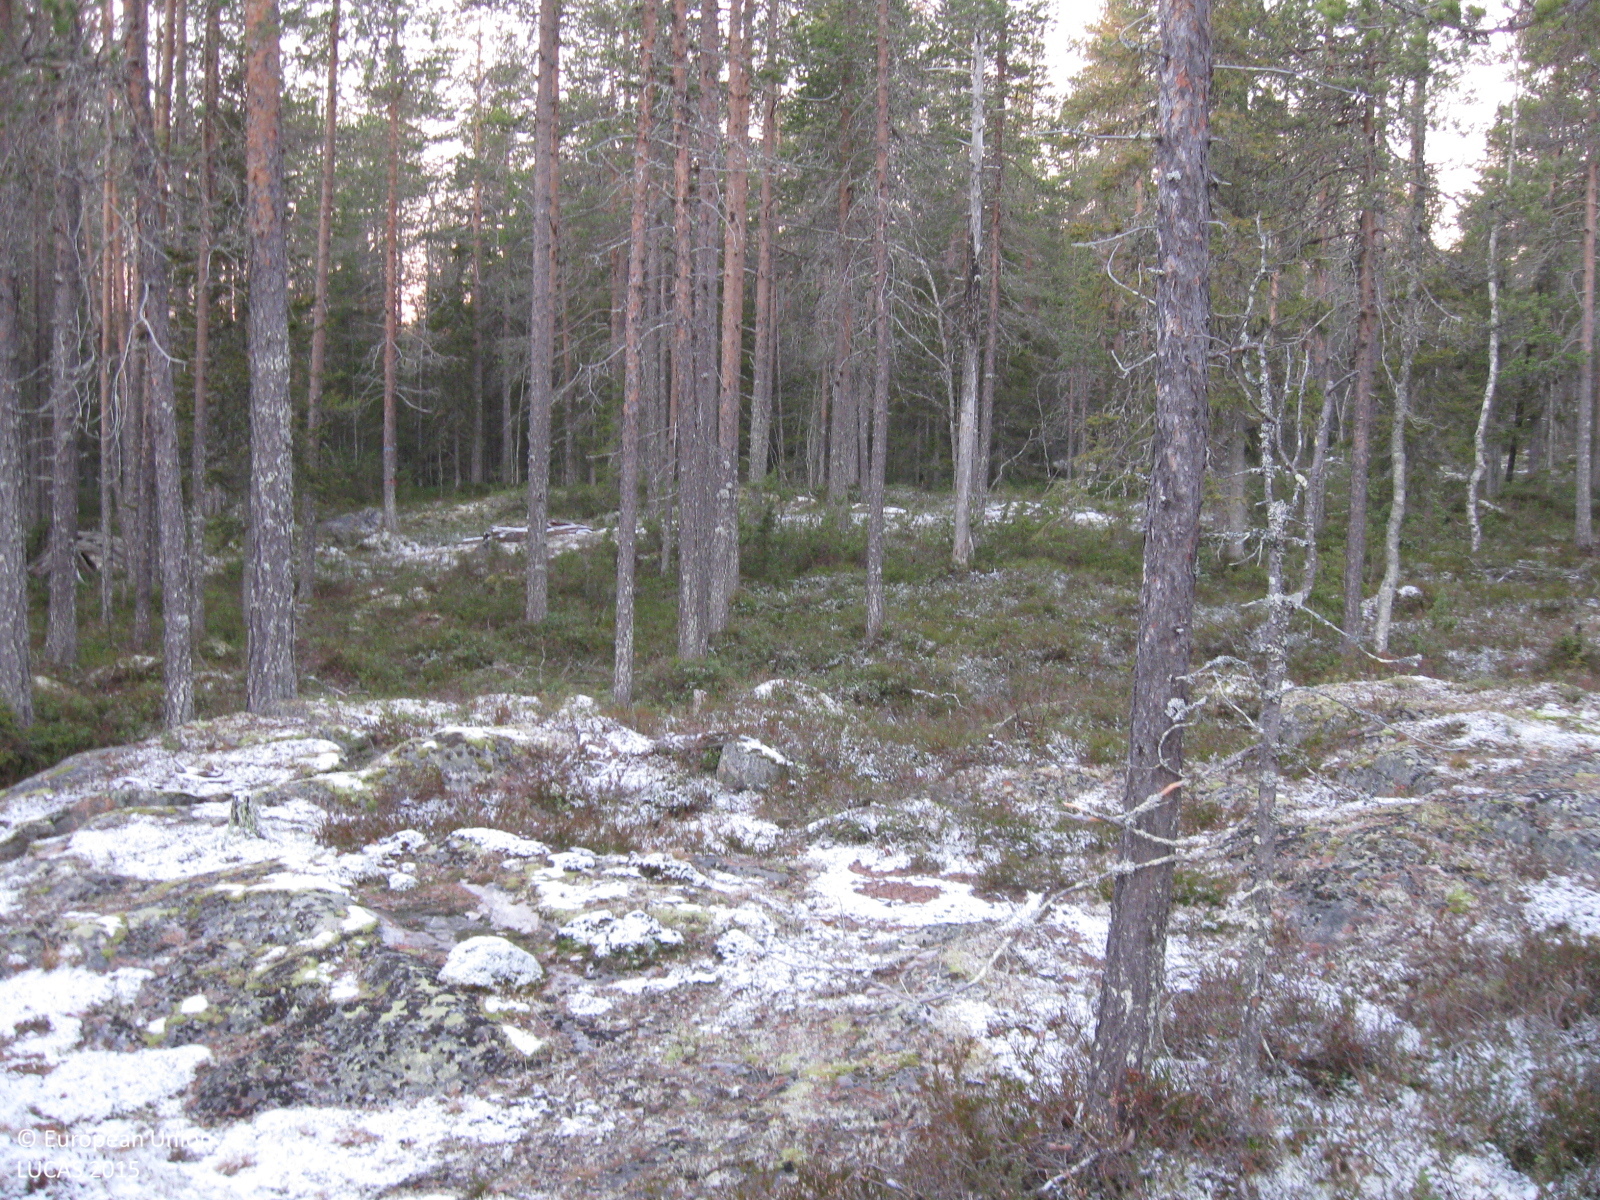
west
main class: Woodland
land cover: Pine dominated coniferous woodland
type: boreal forest
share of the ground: 25 - 50 %
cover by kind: consolidated bare surface 40 %, coniferous forest trees 25 %, shrubs 15 %, lichens and mosses 10 %, broadleaved forest trees 5 %, herbaceous plants 5 %
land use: Forestry
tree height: > 5 m
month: October
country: SE
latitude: 66.1116
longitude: 21.6308
